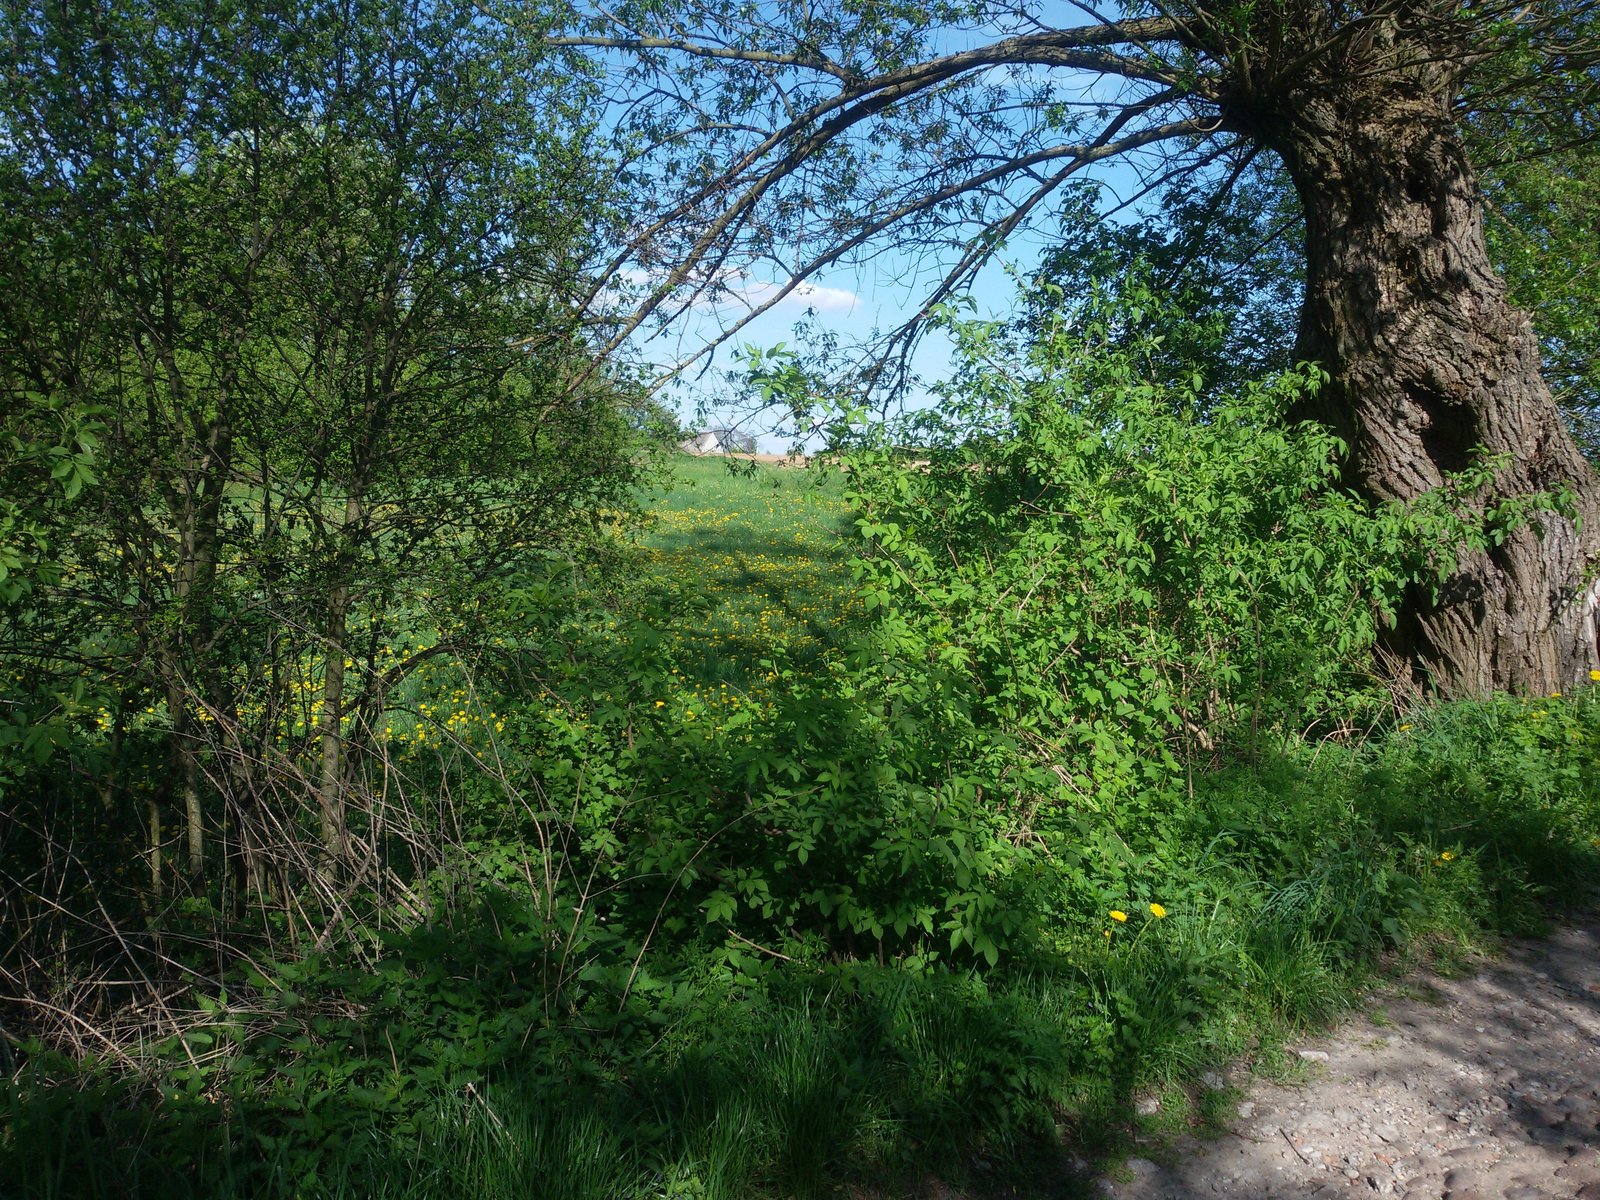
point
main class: Grassland
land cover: Grassland without tree/shrub cover
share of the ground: > 75 %
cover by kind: herbaceous plants 100 %
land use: Agriculture (excluding fallow land and kitchen gardens)
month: May
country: PL
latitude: 52.8051
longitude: 22.3309
